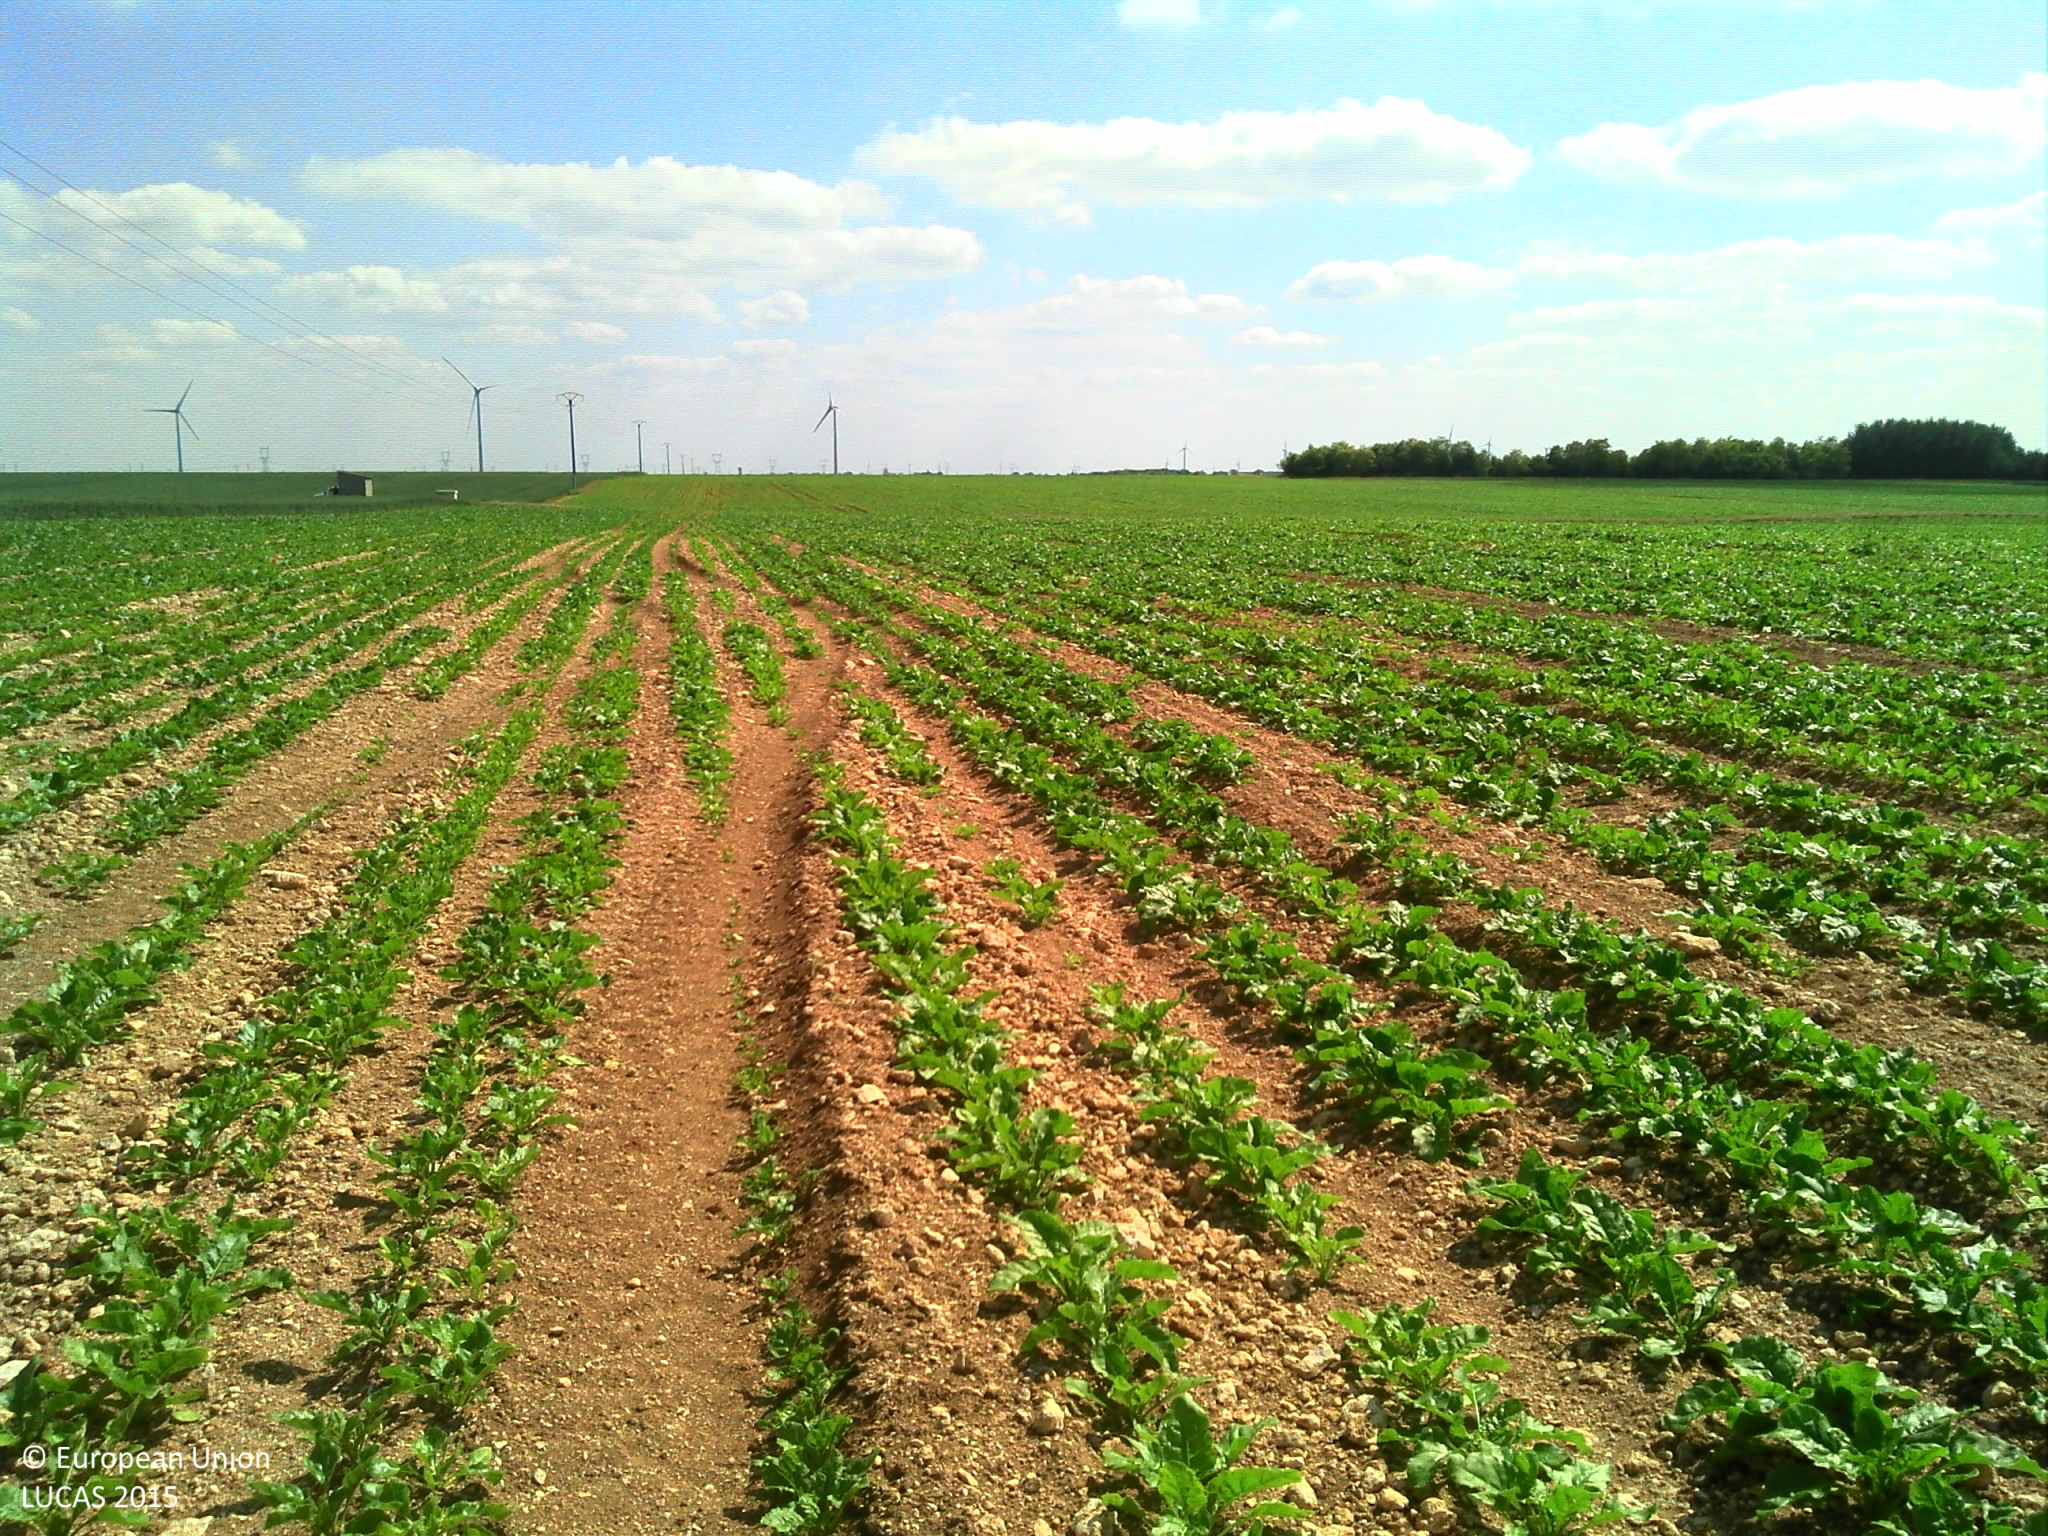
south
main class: Cropland
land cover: Sugar beet
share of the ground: 10 - 25 %
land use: Agriculture (excluding fallow land and kitchen gardens)
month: May
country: FR
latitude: 48.2699
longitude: 1.9162
